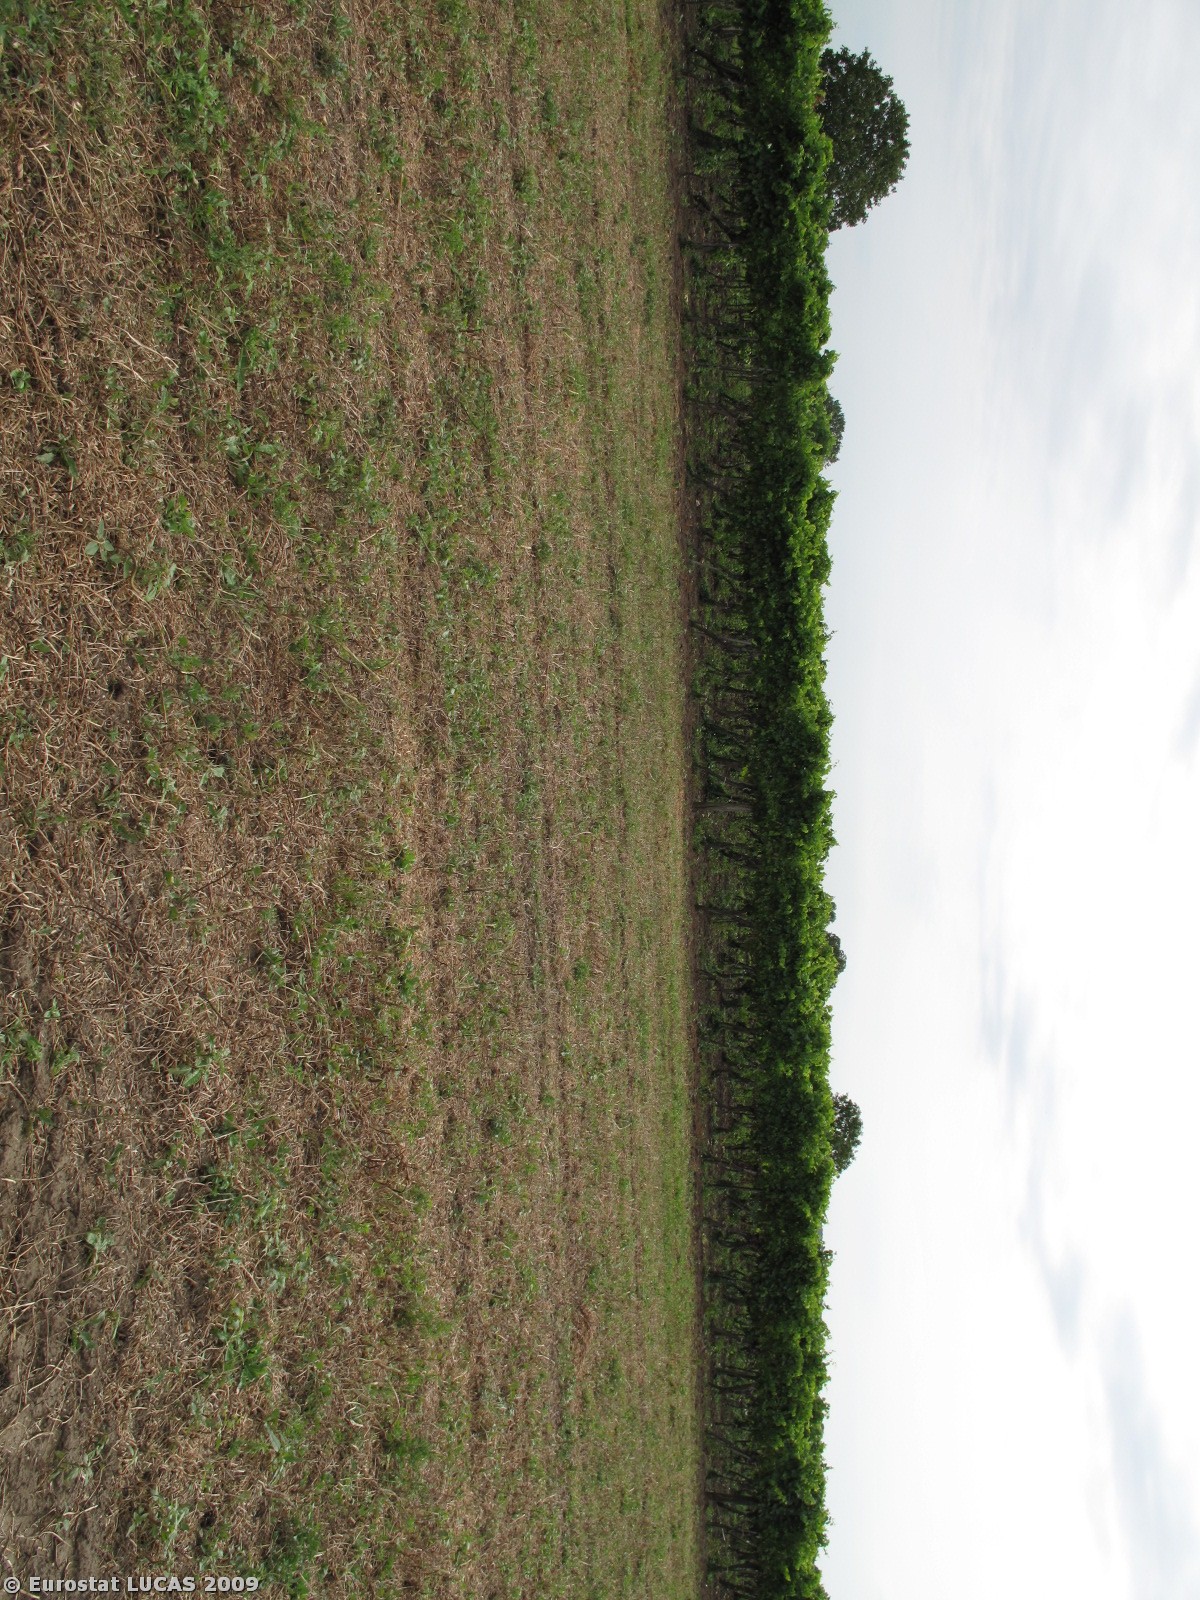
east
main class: Cropland
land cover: Dry pulses
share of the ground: 50 - 75 %
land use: Agriculture (excluding fallow land and kitchen gardens)
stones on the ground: < 10 %
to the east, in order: Dry pulses; Vineyards; Grassland with sparse tree/shrub cover; Tracks; Common wheat; Tracks; Grass margins; Common wheat; Grassland without tree/shrub cover
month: May
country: AT
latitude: 48.6889
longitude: 16.0497
